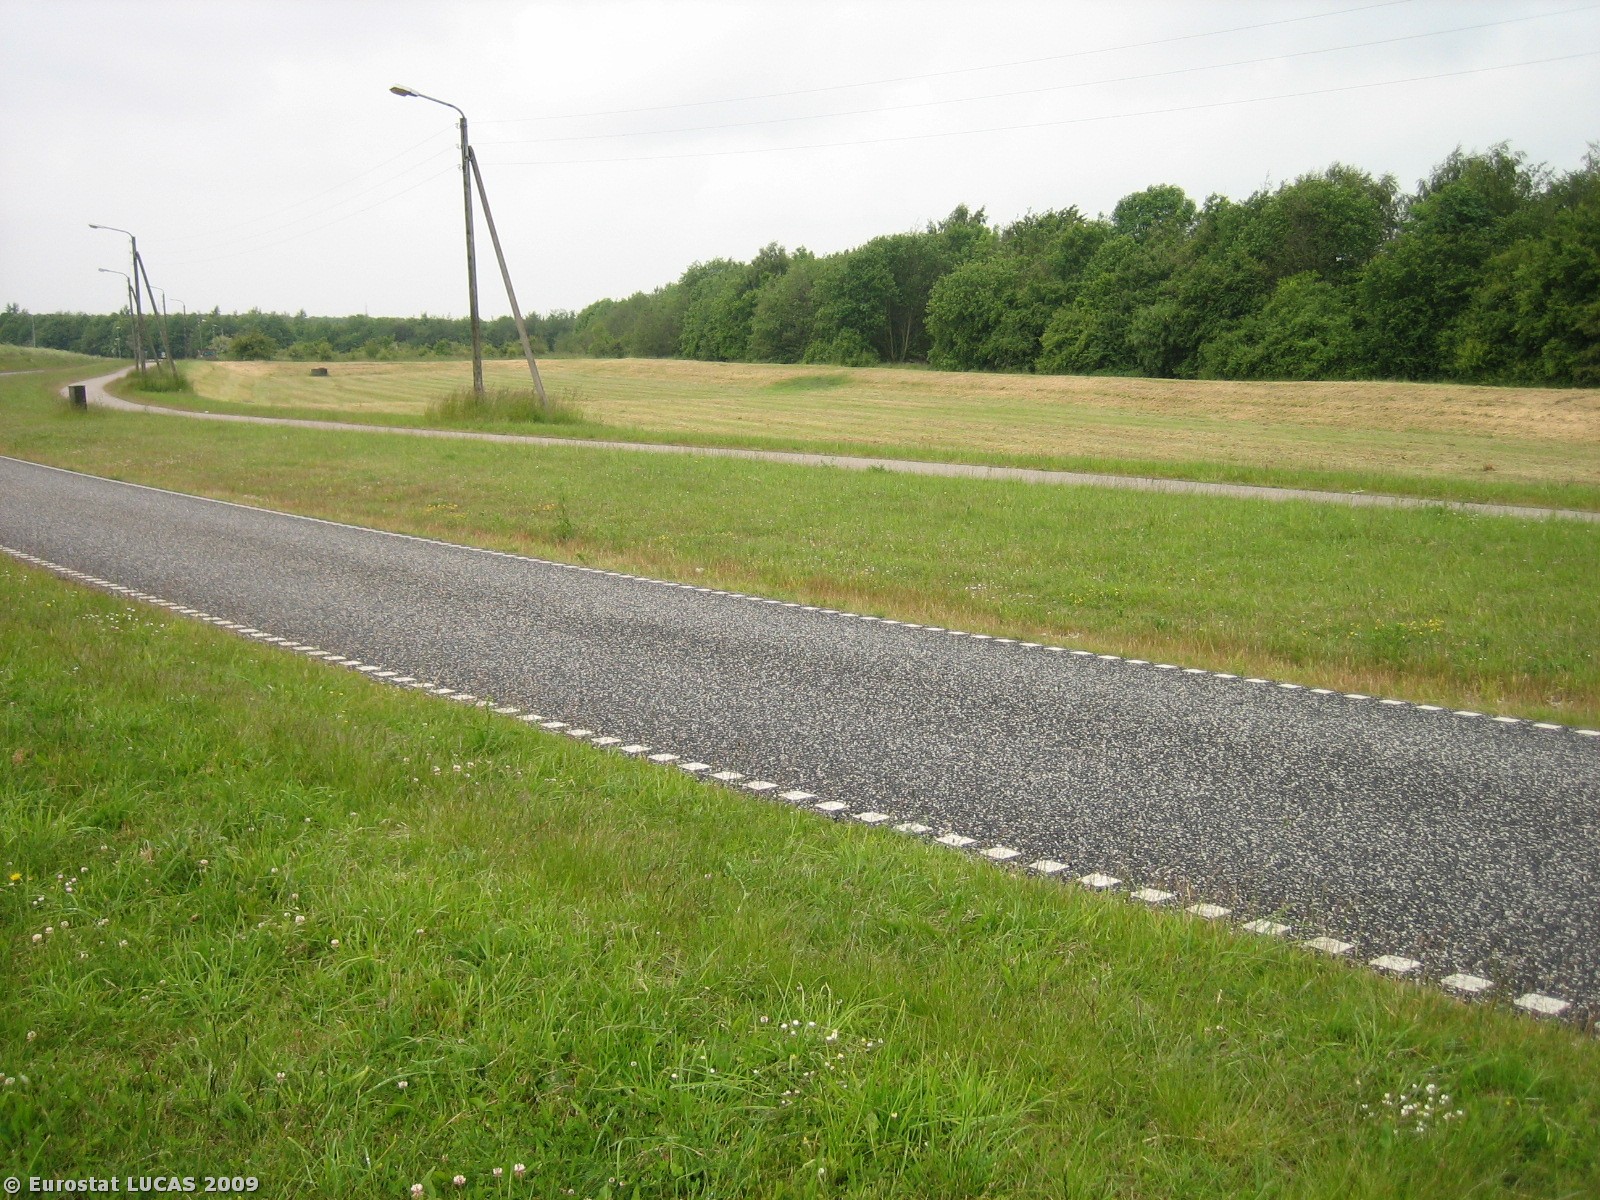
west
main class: Grassland
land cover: Grassland without tree/shrub cover
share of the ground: > 75 %
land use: Unused
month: June
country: DK
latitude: 56.1876
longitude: 10.1770
